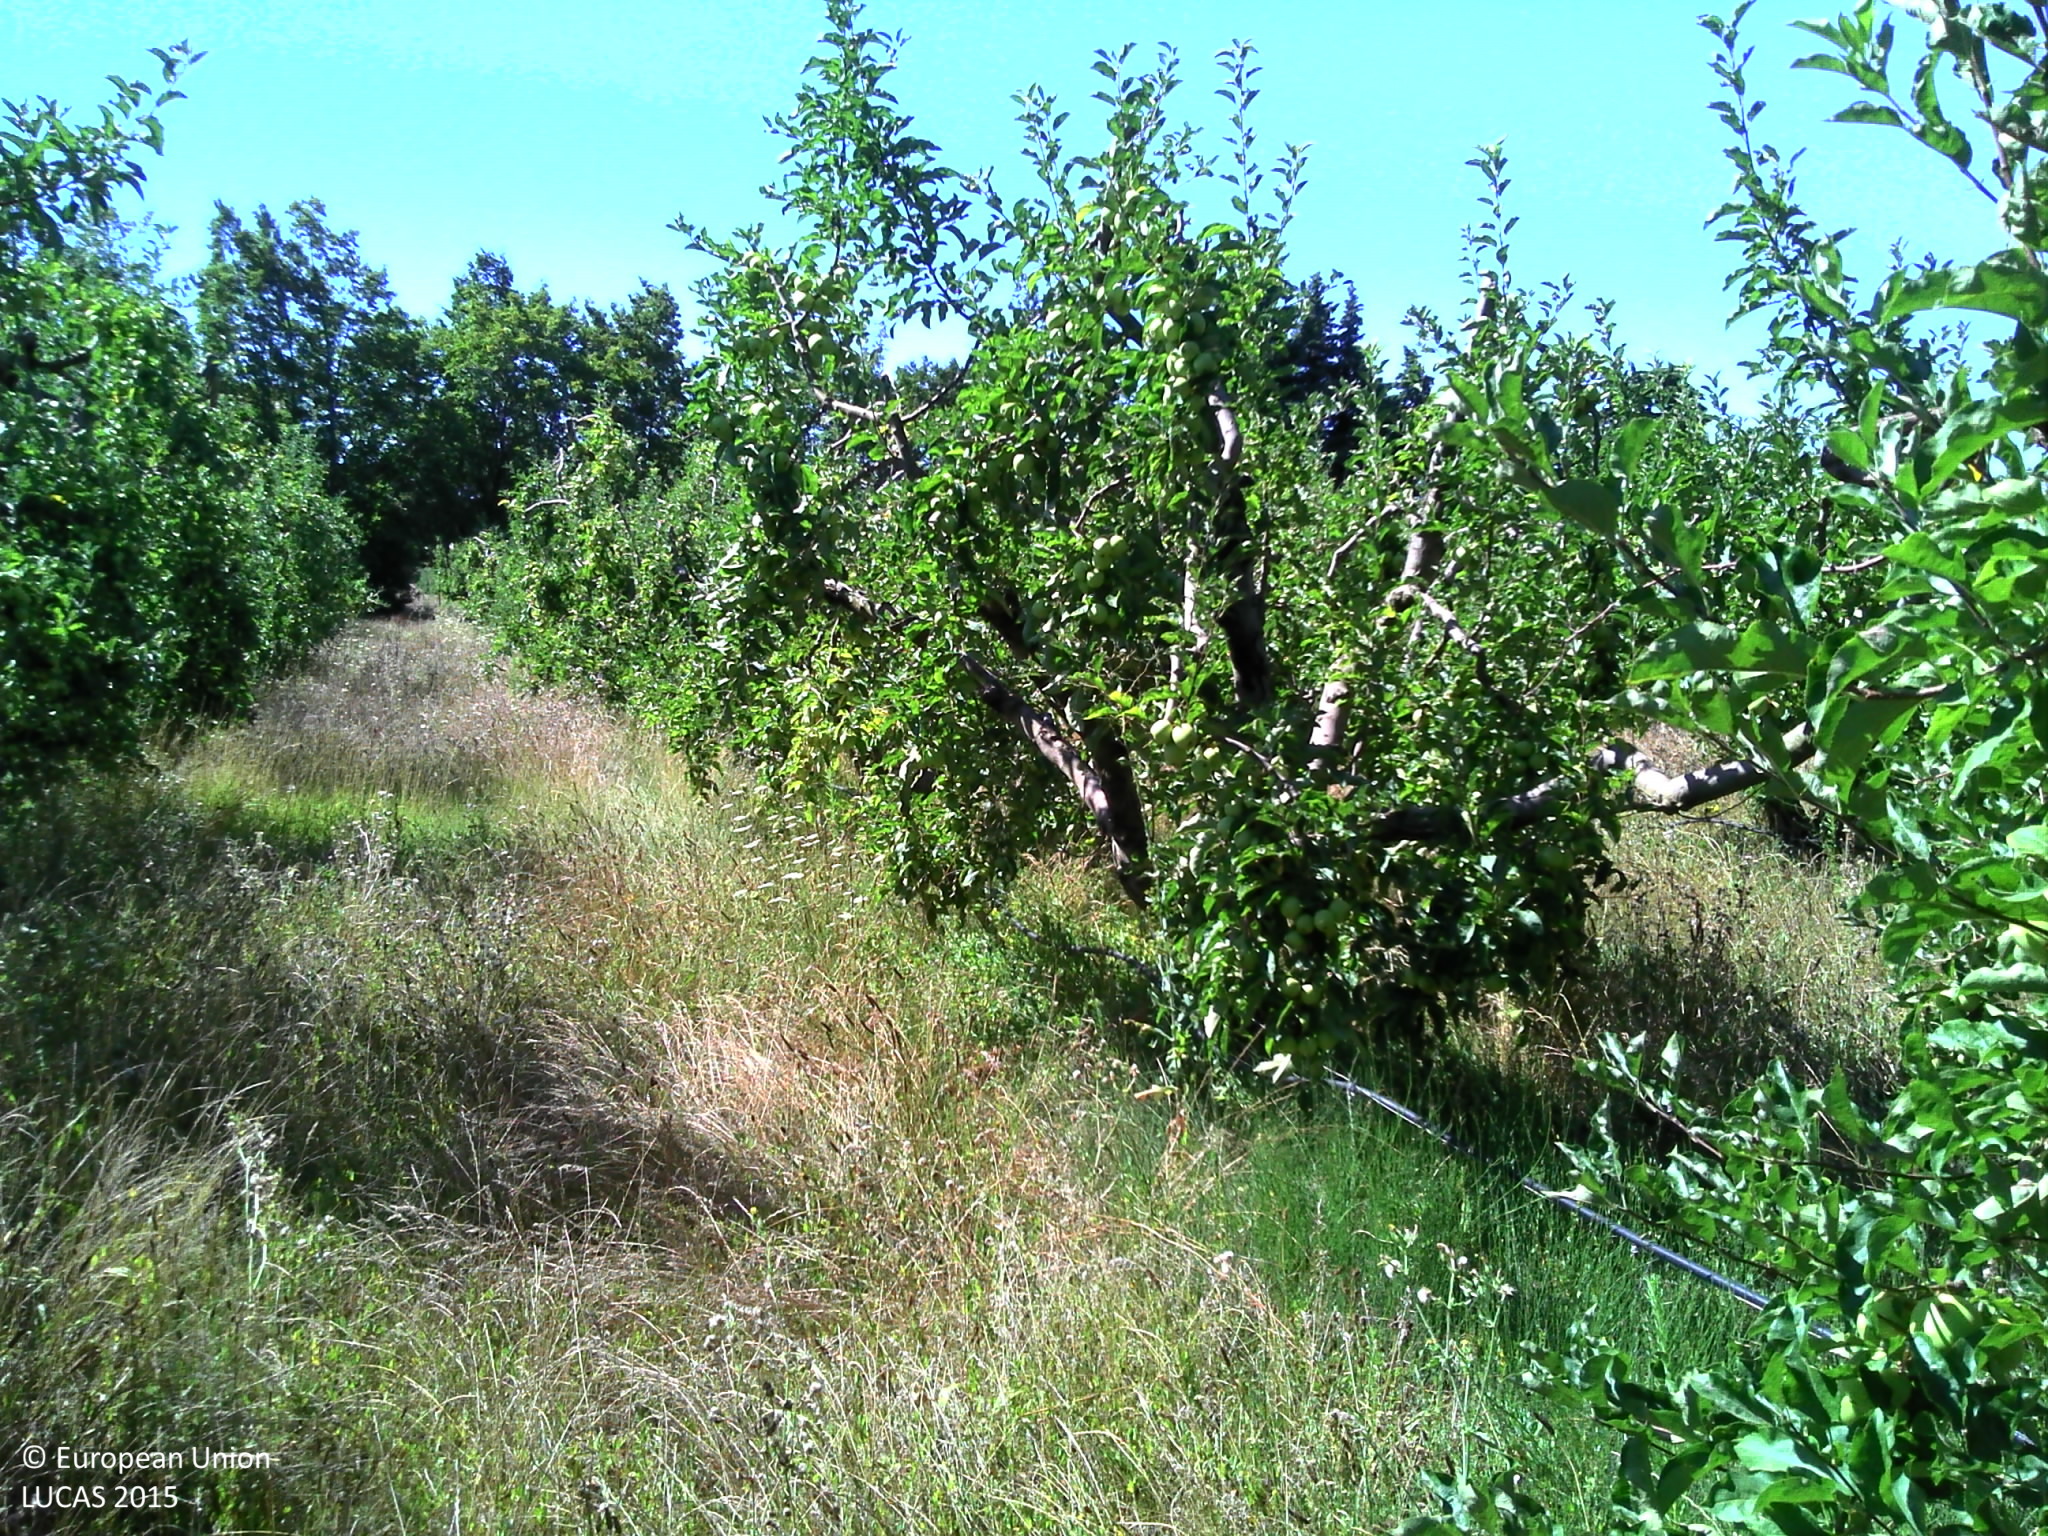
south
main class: Cropland
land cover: Apple fruit
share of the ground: 50 - 75 %
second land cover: Grassland without tree/shrub cover
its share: 50 - 75 %
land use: Agriculture (excluding fallow land and kitchen gardens)
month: July
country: FR
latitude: 43.8539
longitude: 5.0700
